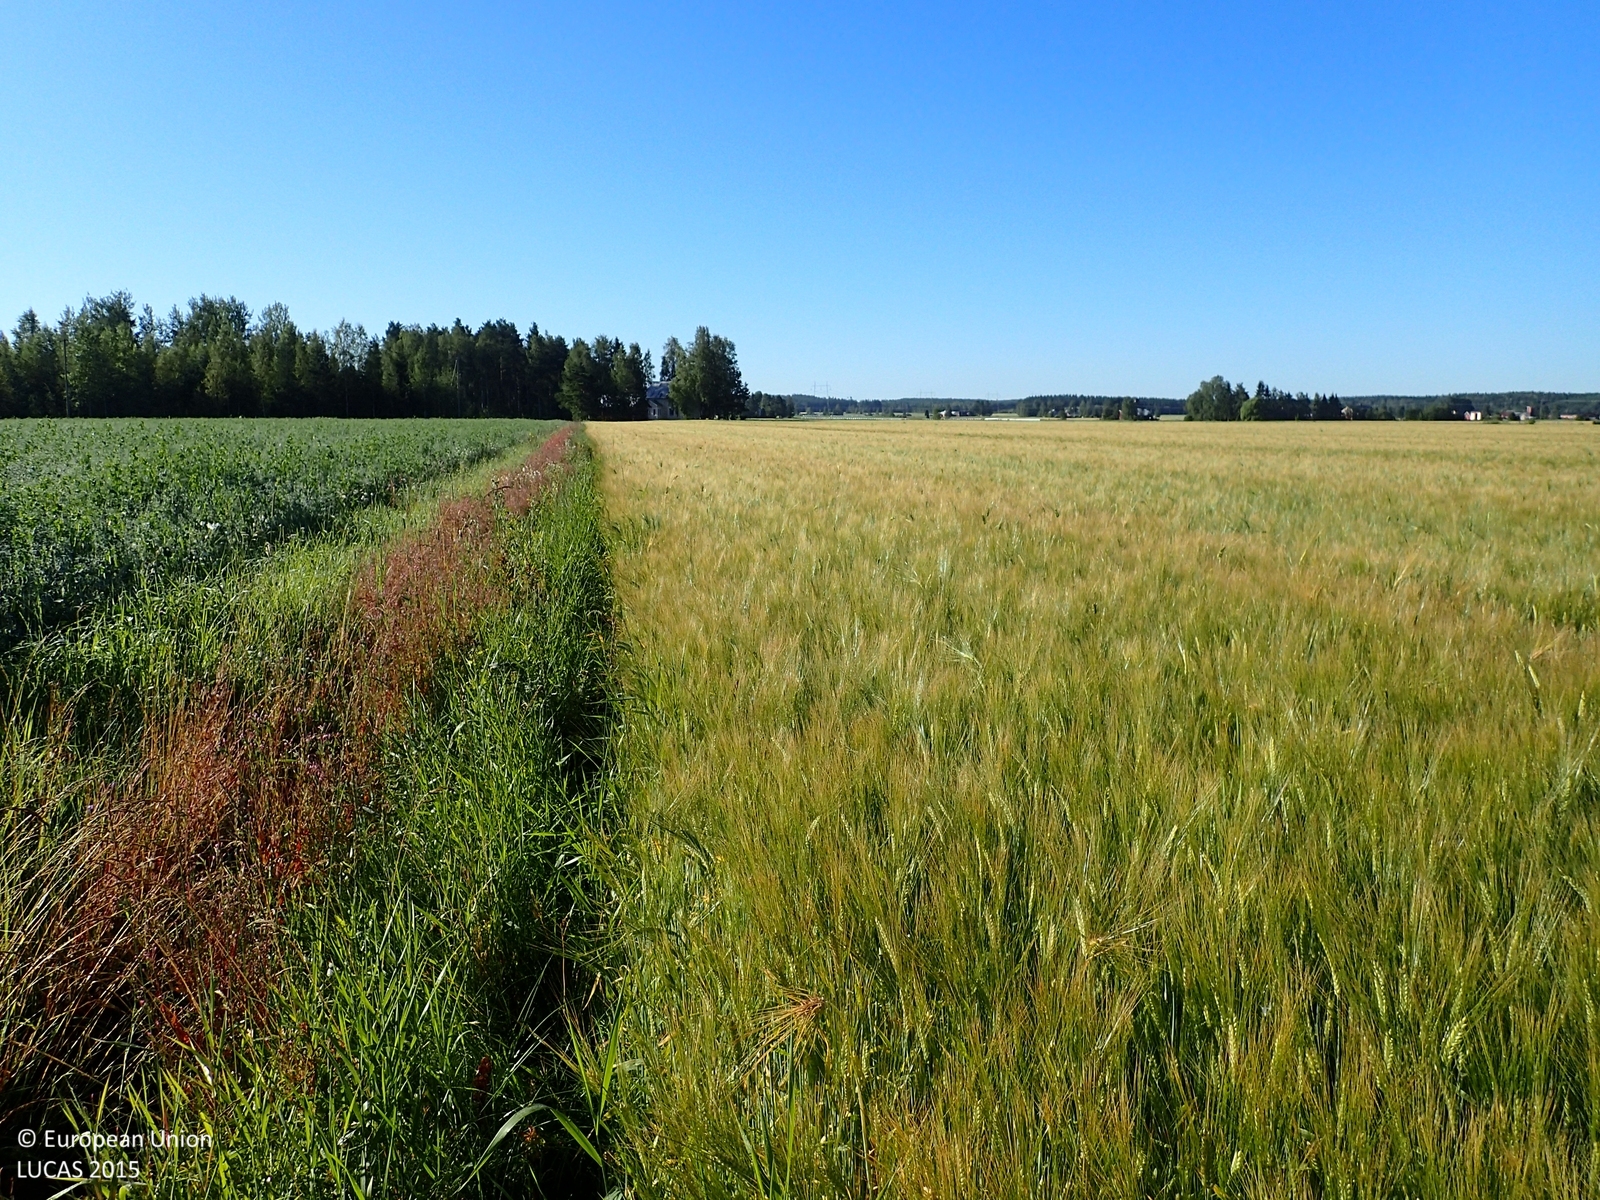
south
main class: Cropland
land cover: Barley
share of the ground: > 75 %
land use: Agriculture (excluding fallow land and kitchen gardens)
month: August
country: FI
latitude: 62.5804
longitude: 22.5326
